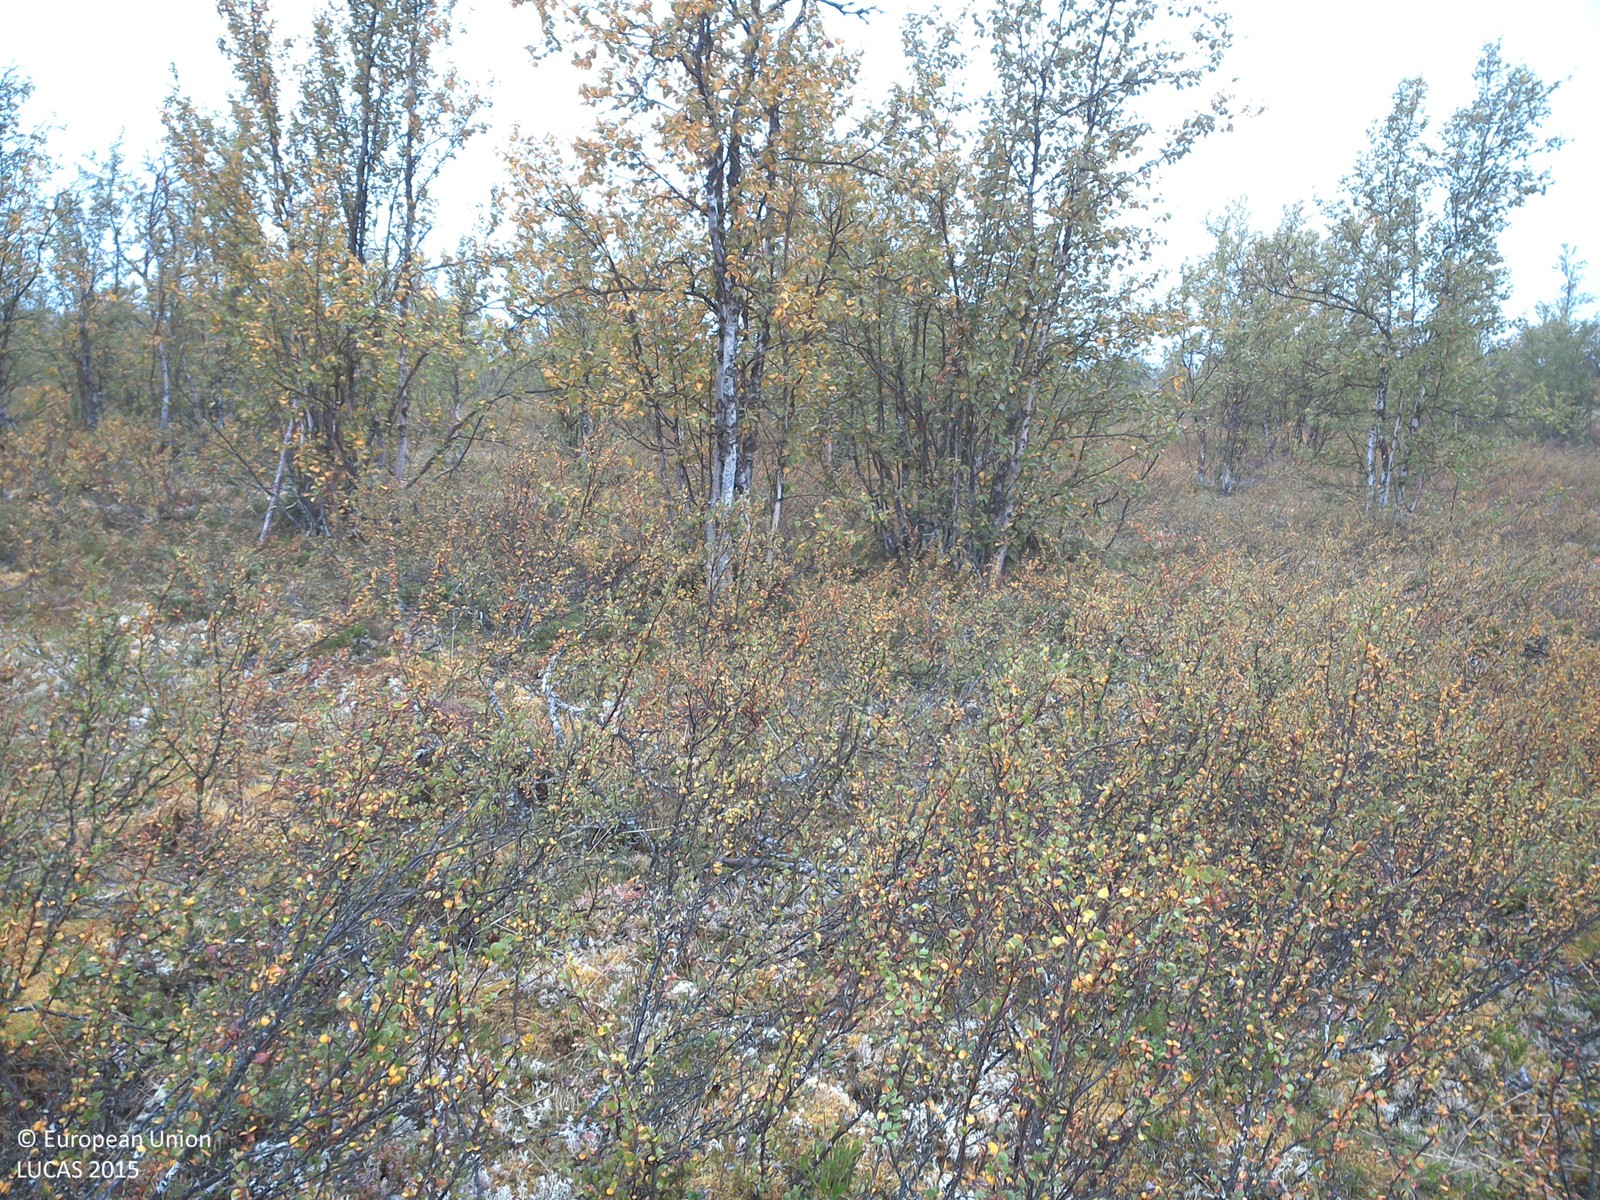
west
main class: Woodland
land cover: Broadleaved woodland
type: boreal forest
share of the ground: 10 - 25 %
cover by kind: shrubs 55 %, lichens and mosses 25 %, broadleaved forest trees 20 %
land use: Amenities, museums, leisure
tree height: > 5 m
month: August
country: SE
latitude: 68.1913
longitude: 21.8335
